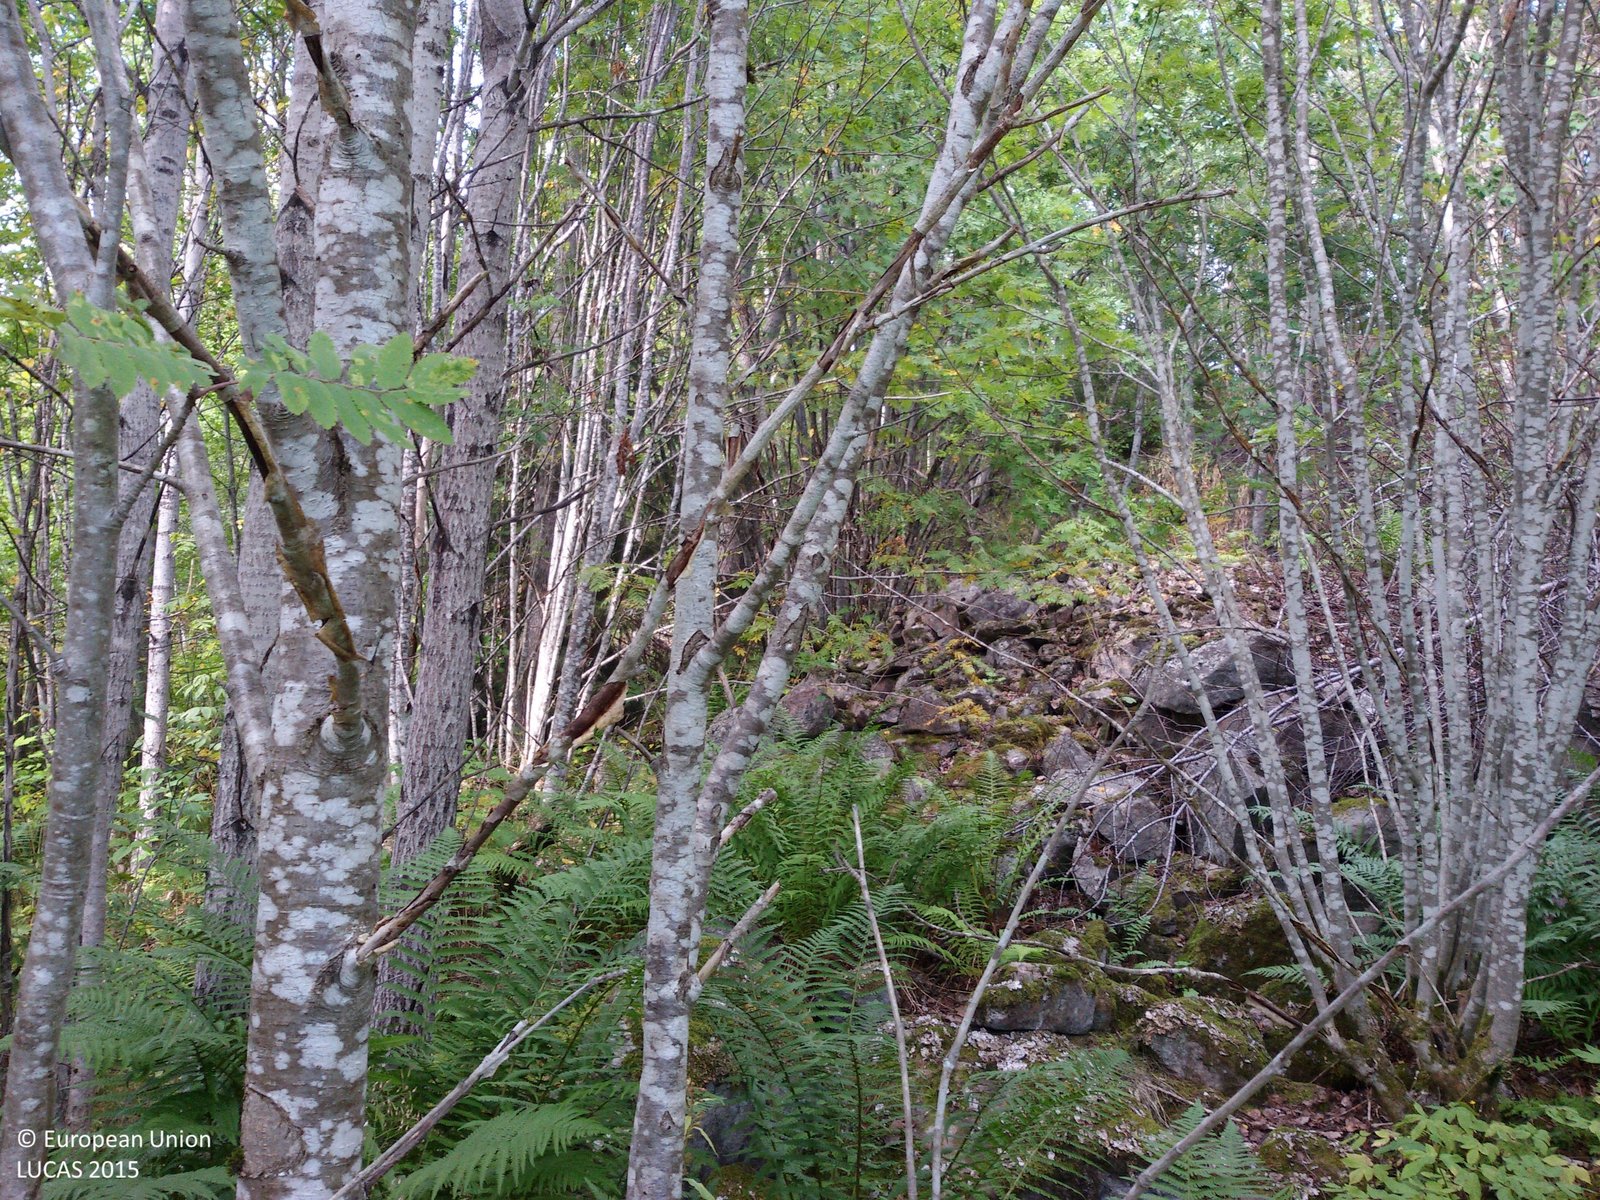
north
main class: Woodland
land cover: Broadleaved woodland
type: hemiboreal forest and nemoral coniferous forest and mixed broadleaved-coniferous forest
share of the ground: 50 - 75 %
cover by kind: broadleaved forest trees 90 %, herbaceous plants 10 %
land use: Forestry
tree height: > 5 m
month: August
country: SE
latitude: 60.8282
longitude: 16.0375
